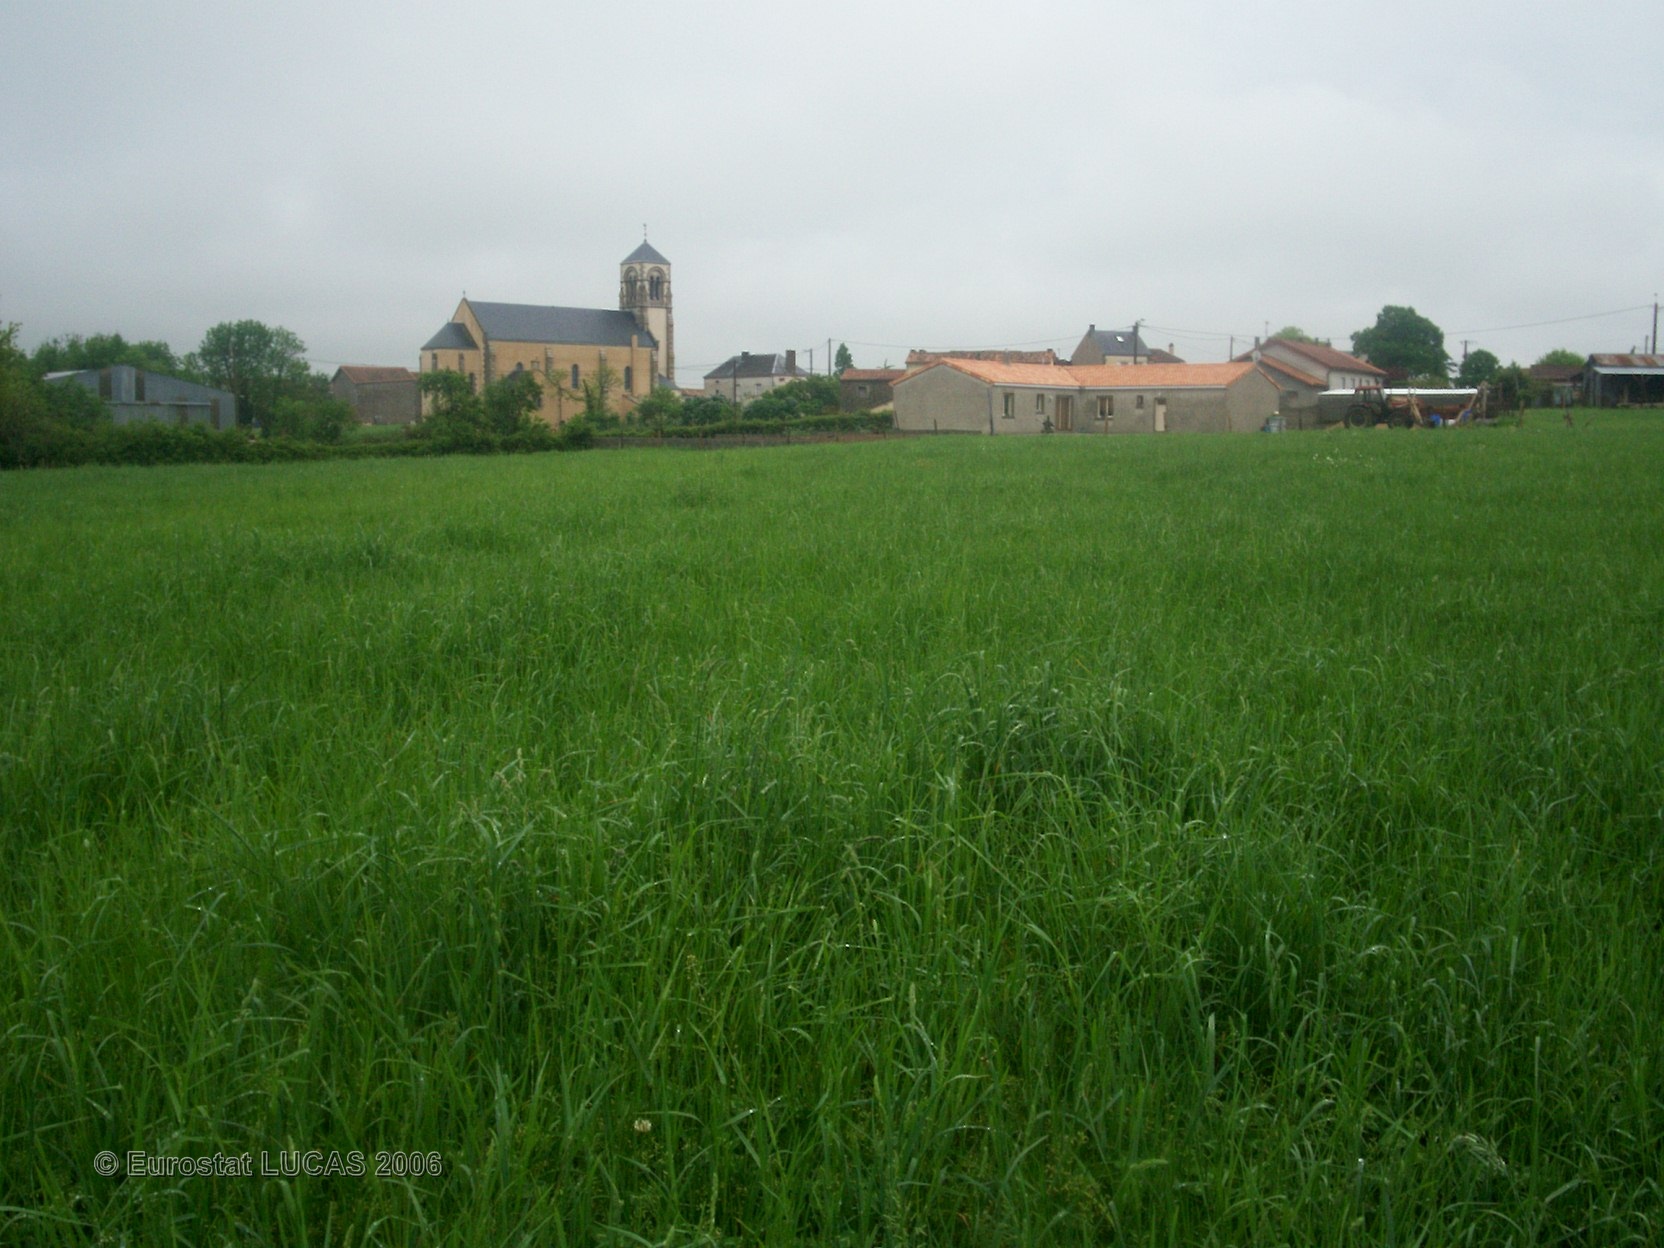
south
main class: Grassland
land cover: Grassland without tree/shrub cover
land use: Agriculture (excluding fallow land and kitchen gardens)
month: April
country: FR
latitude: 46.7191
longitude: -0.3484
